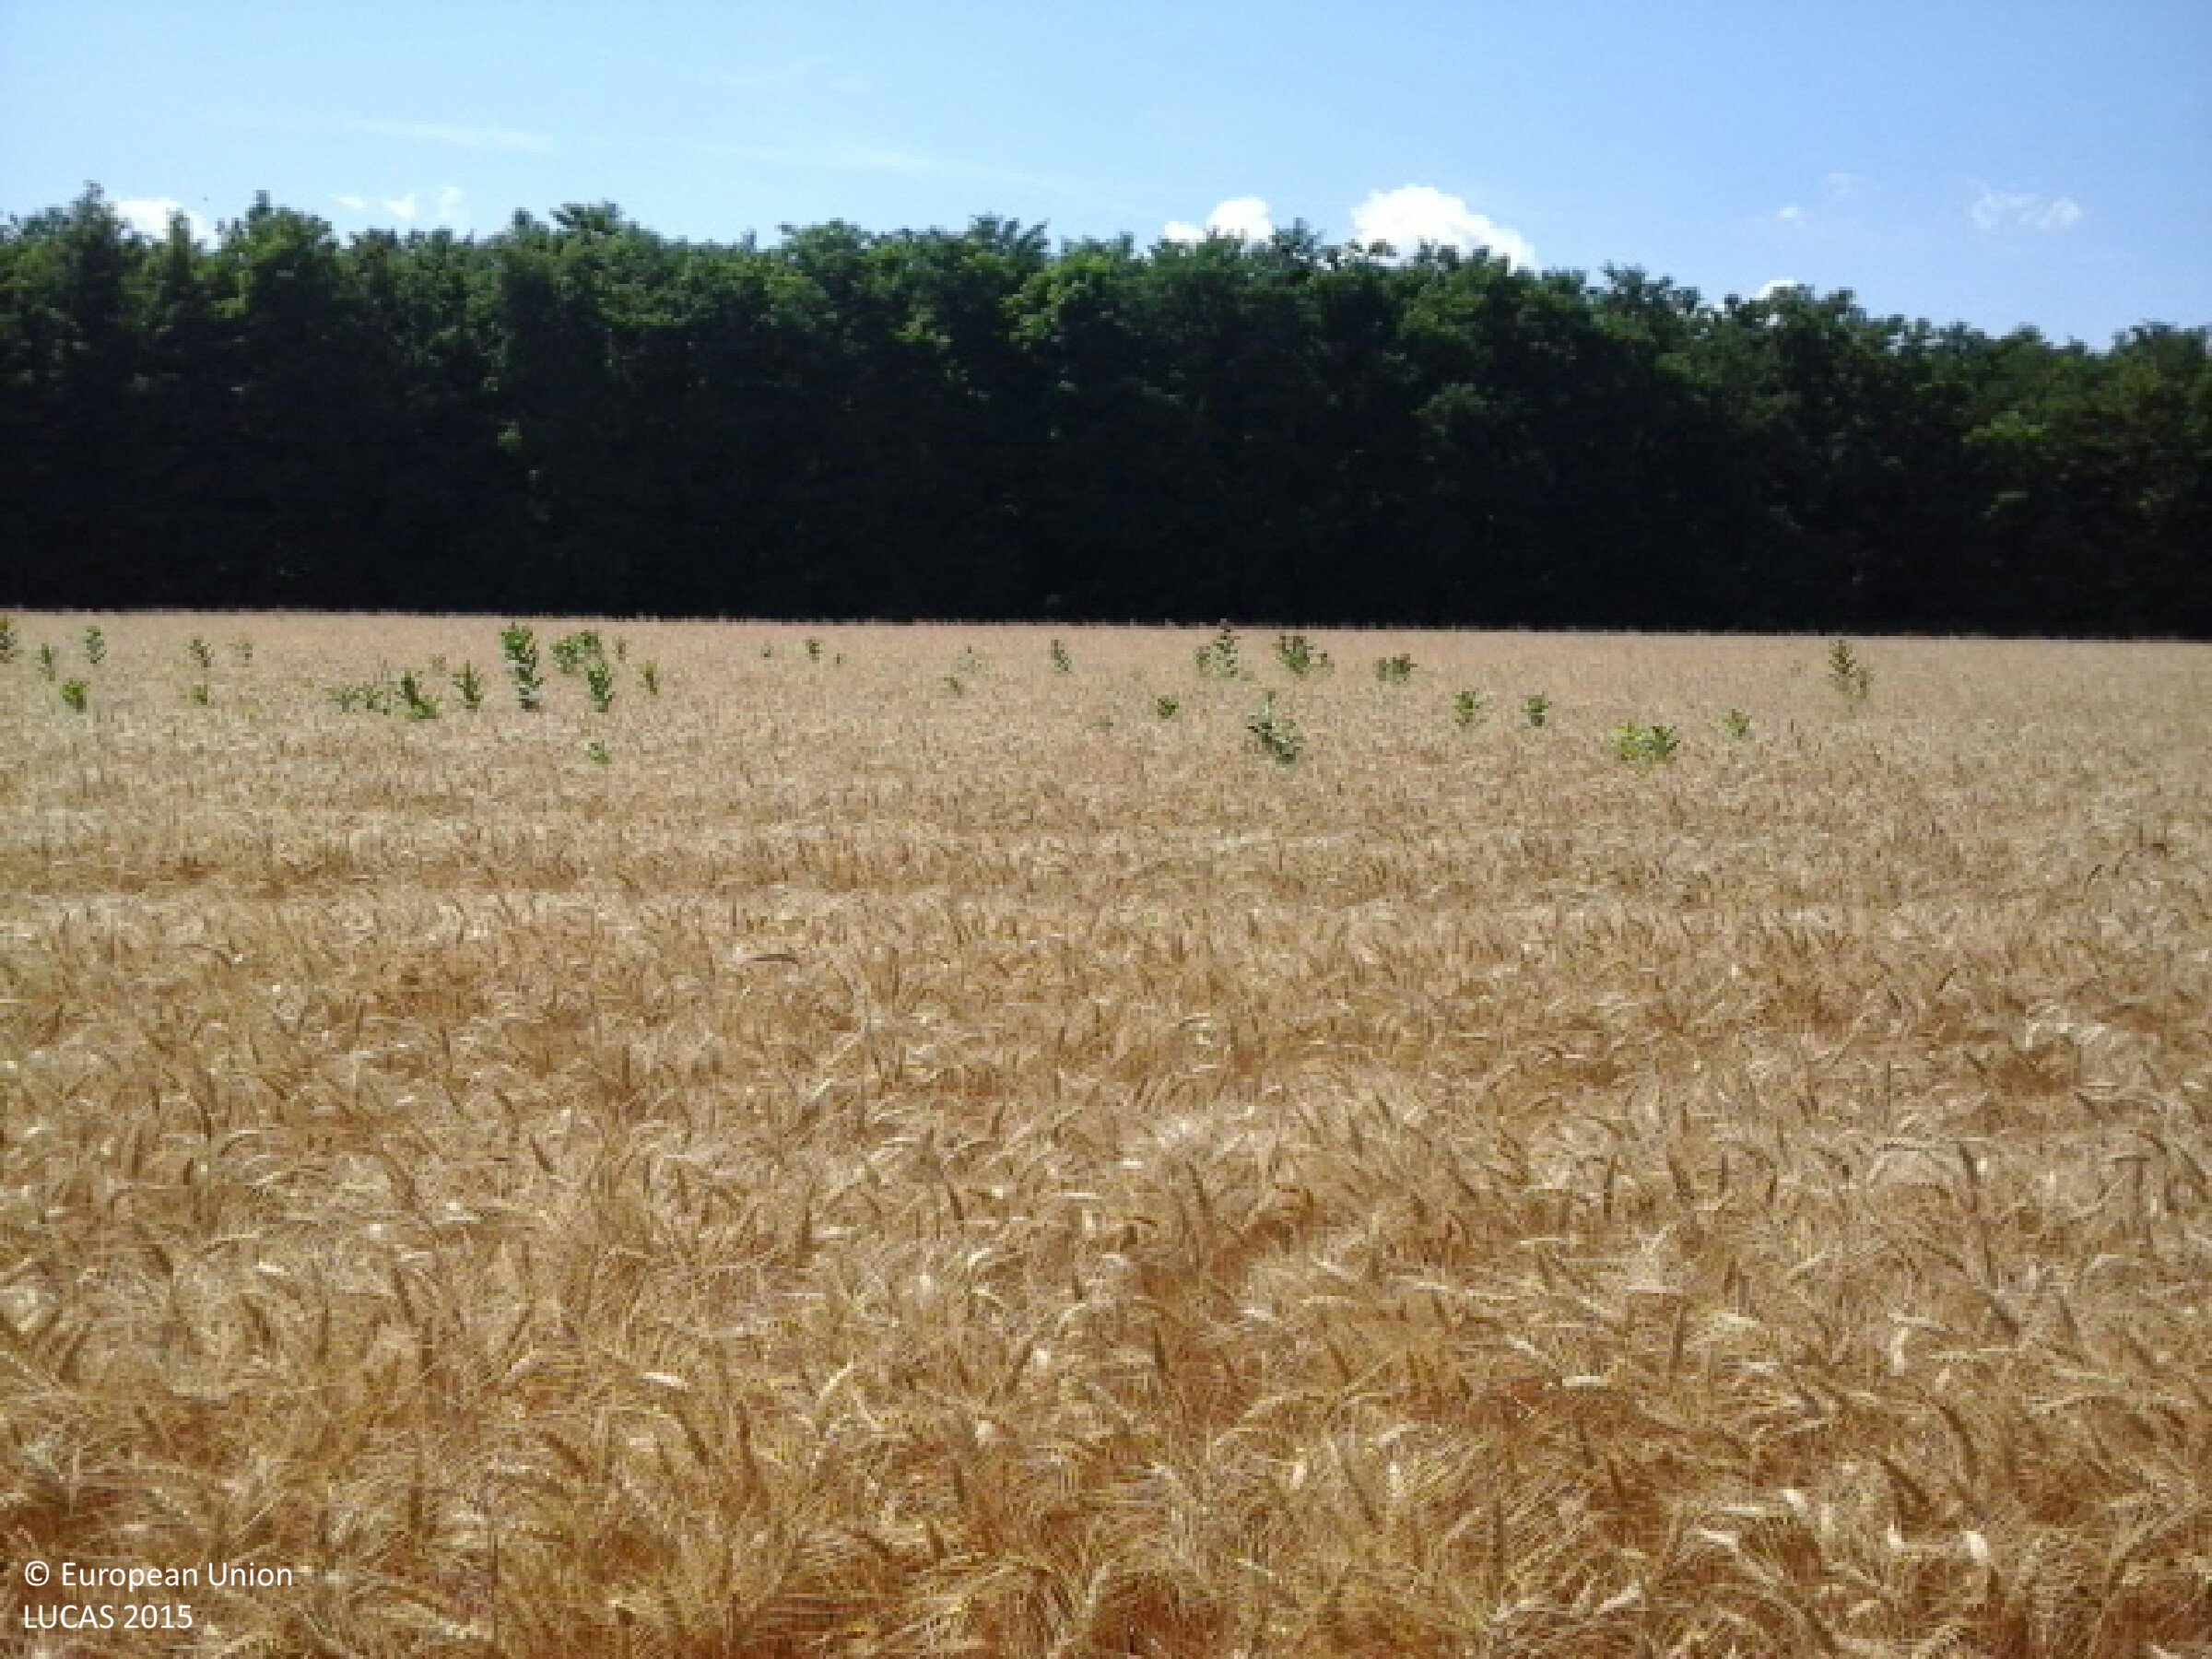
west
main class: Cropland
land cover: Durum wheat
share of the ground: > 75 %
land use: Agriculture (excluding fallow land and kitchen gardens)
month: July
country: HU
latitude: 47.9257
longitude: 22.3563
